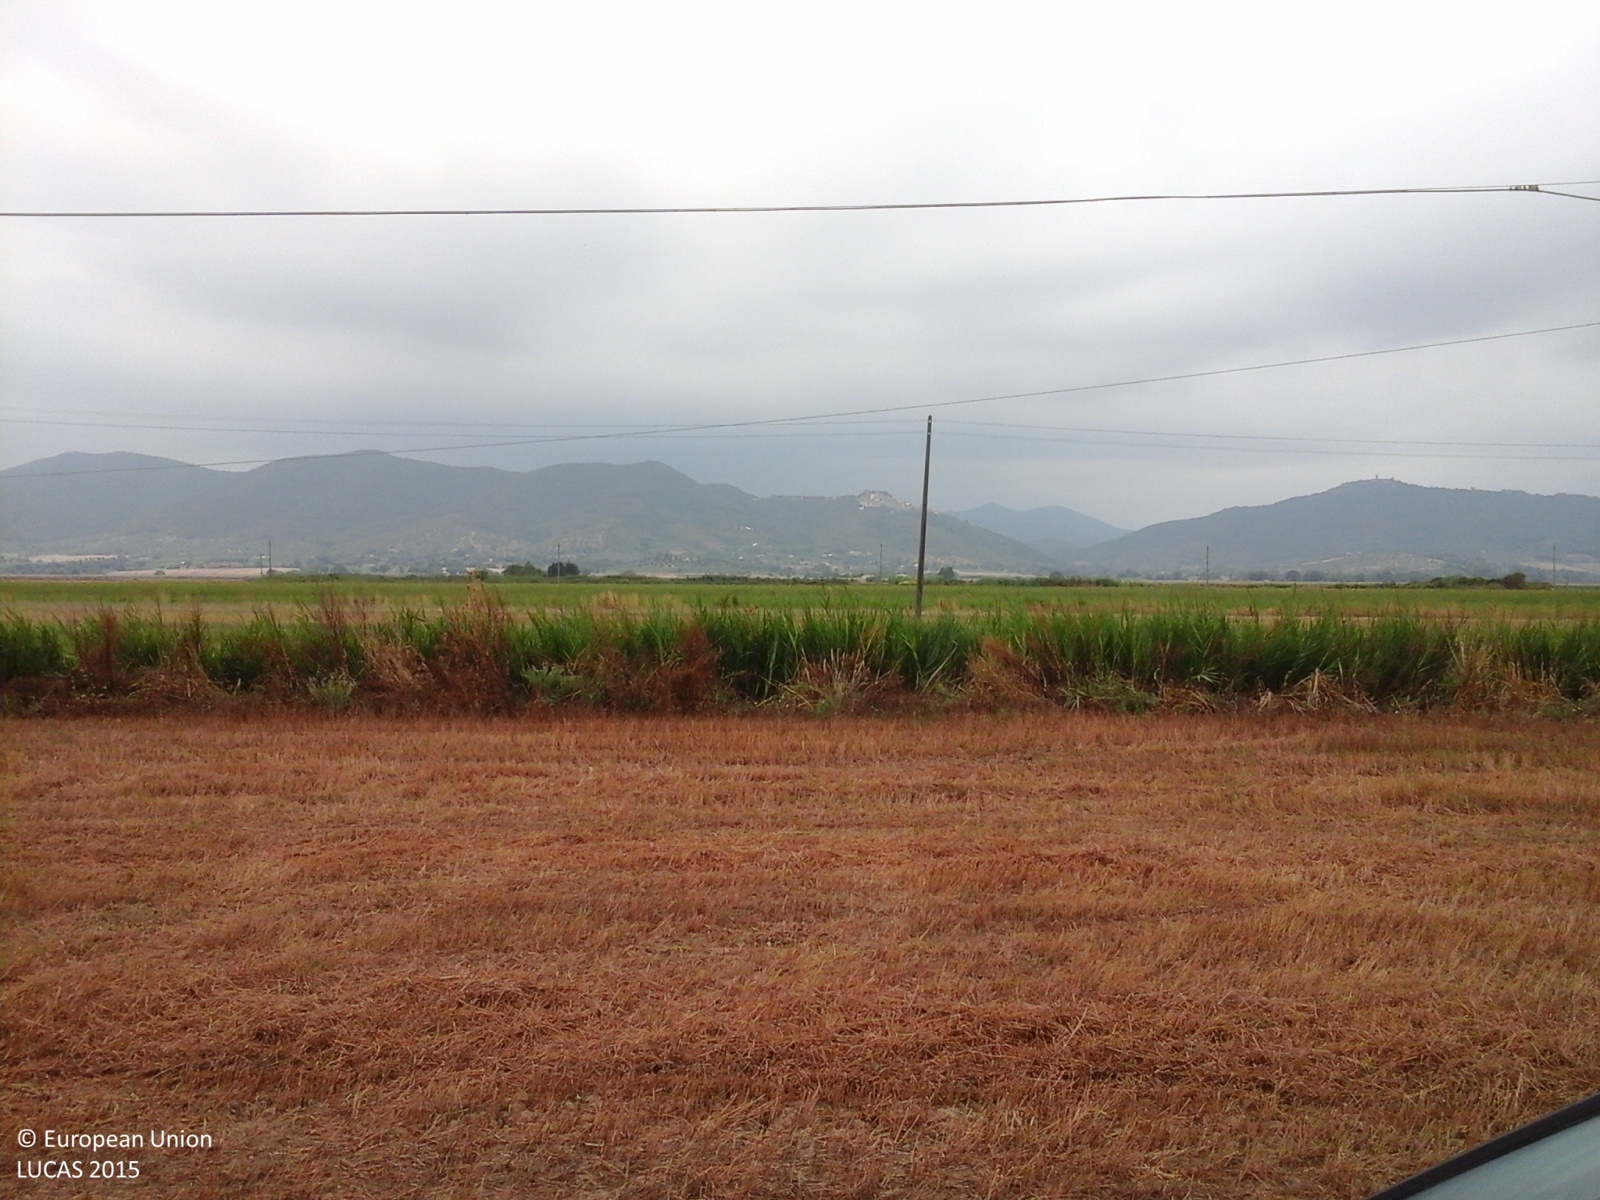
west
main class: Cropland
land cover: Clovers
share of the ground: > 75 %
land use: Agriculture (excluding fallow land and kitchen gardens)
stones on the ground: < 10 %
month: August
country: IT
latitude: 42.8474
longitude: 11.0367
